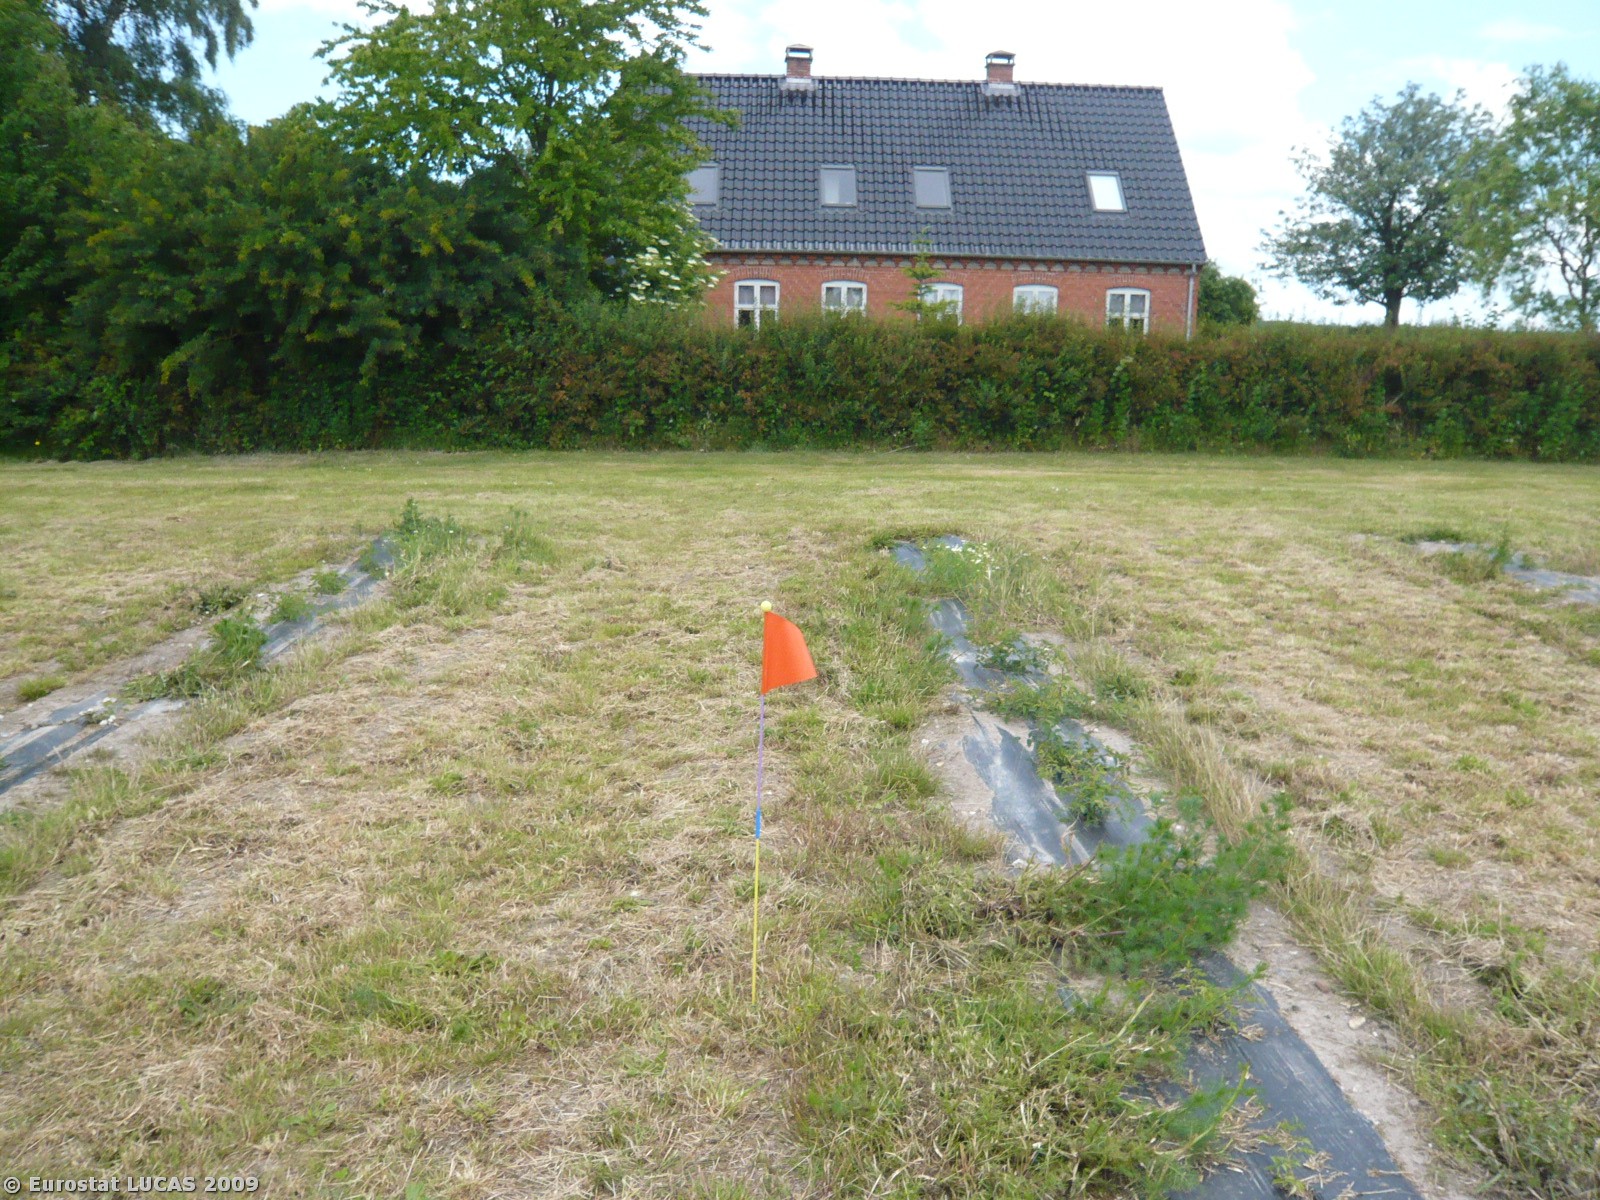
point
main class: Cropland
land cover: Common wheat
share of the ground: 10 - 25 %
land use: Agriculture (excluding fallow land and kitchen gardens)
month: June
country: DK
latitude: 54.7572
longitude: 11.6305
